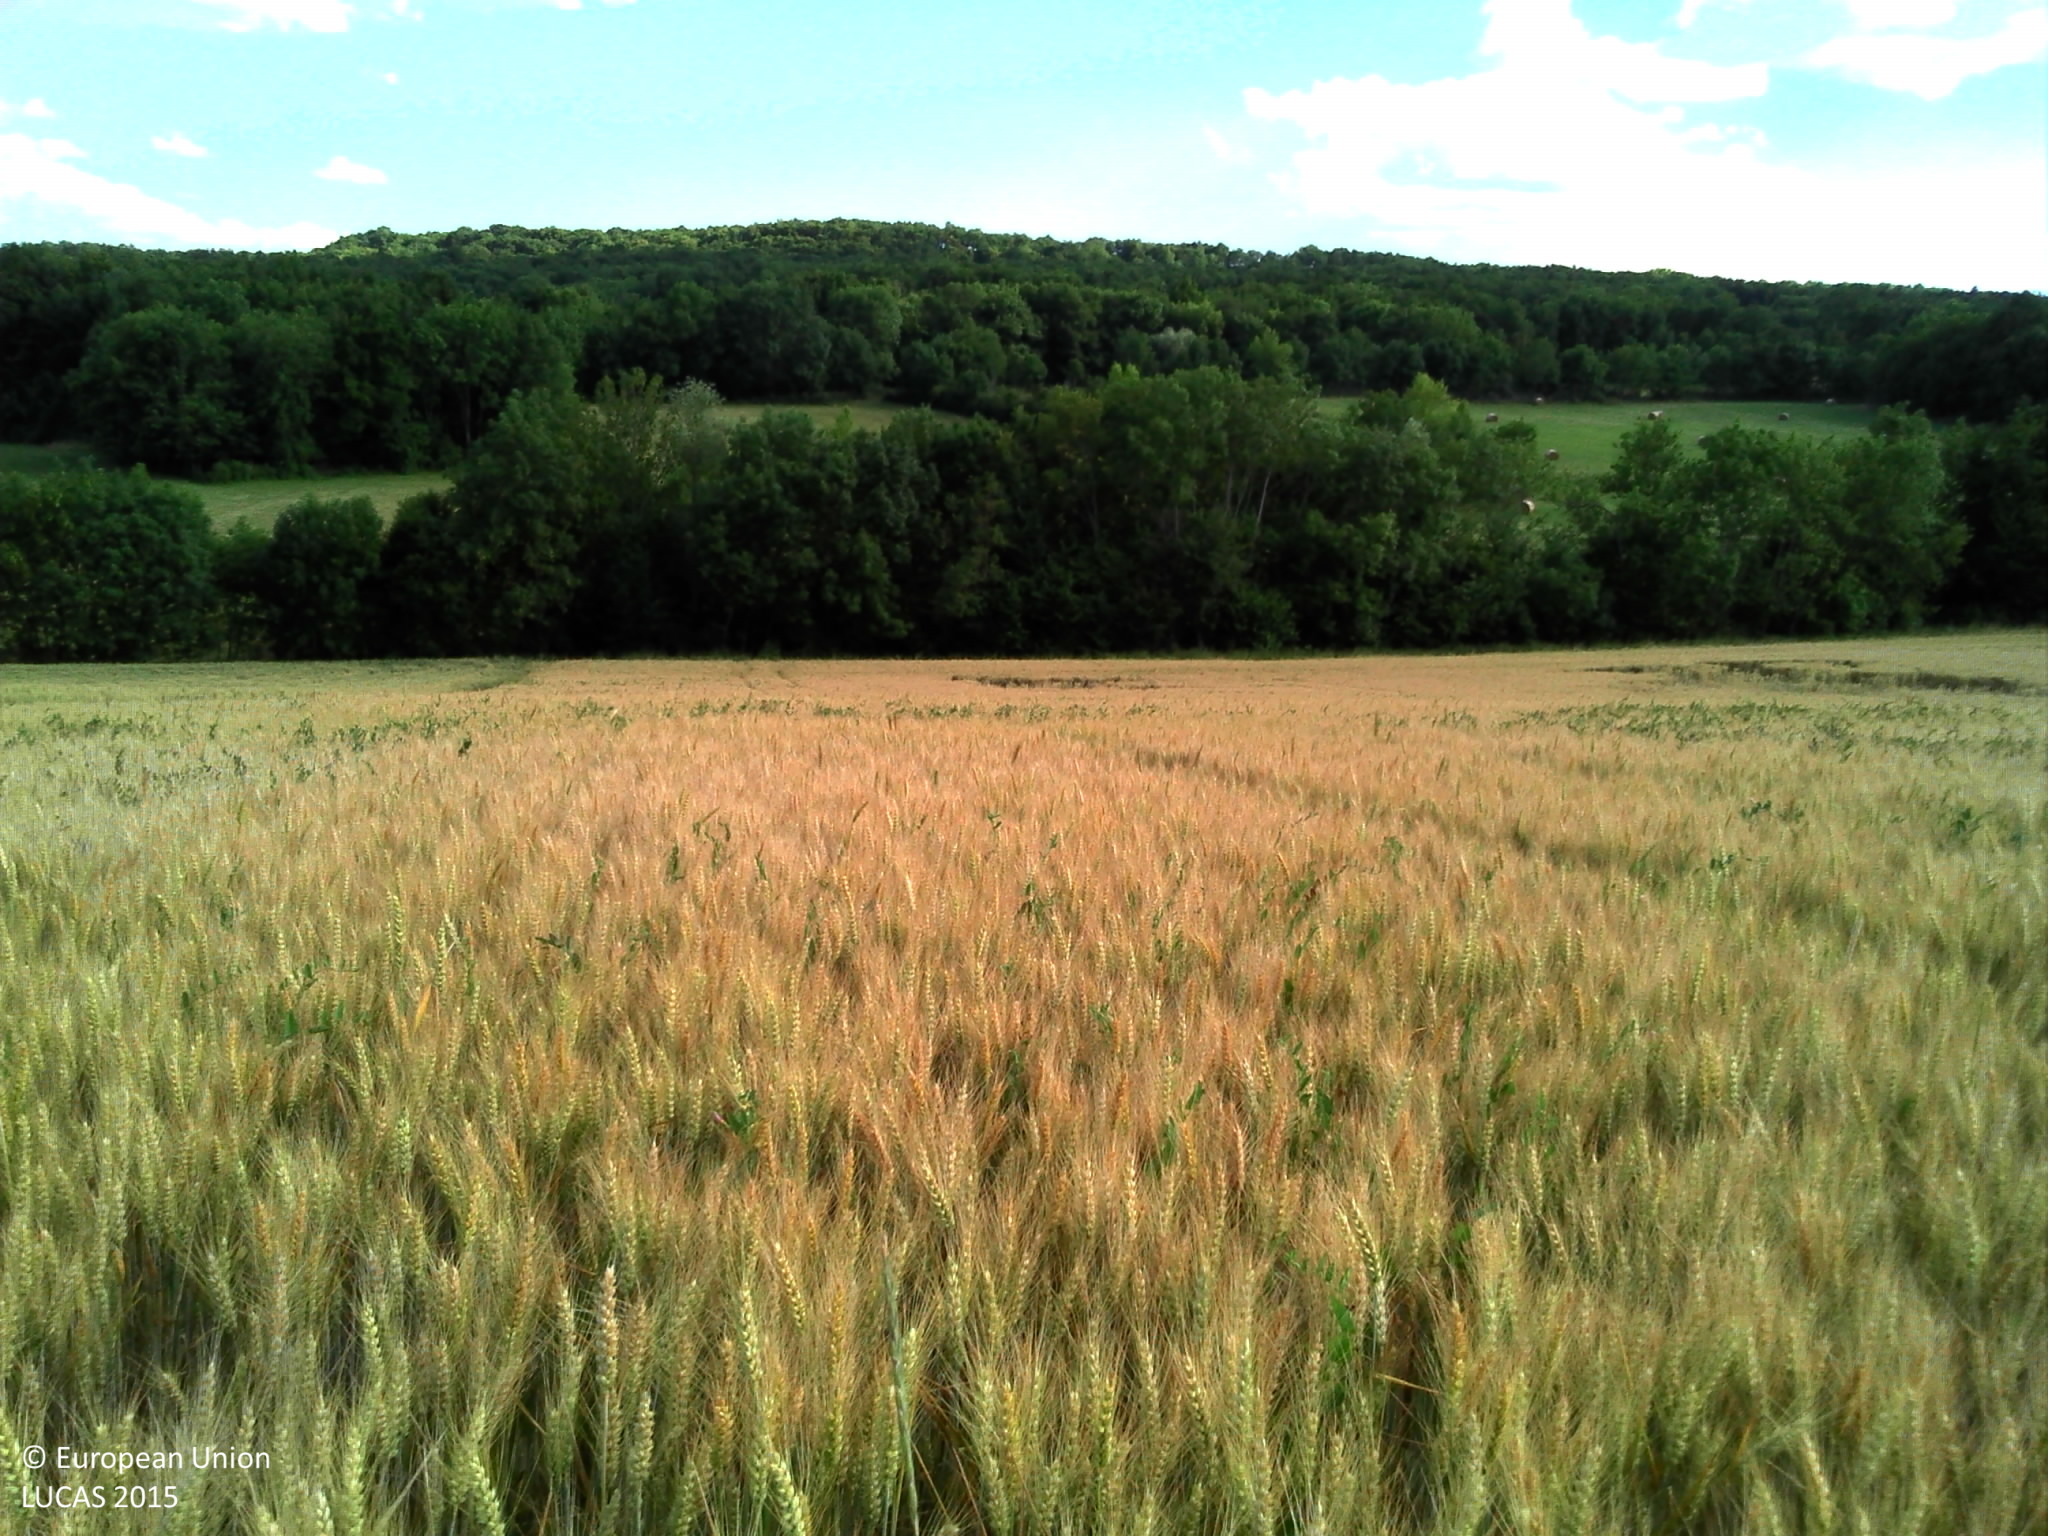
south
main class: Cropland
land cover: Common wheat
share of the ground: > 75 %
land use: Agriculture (excluding fallow land and kitchen gardens)
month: June
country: FR
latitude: 45.4974
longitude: 3.1287
